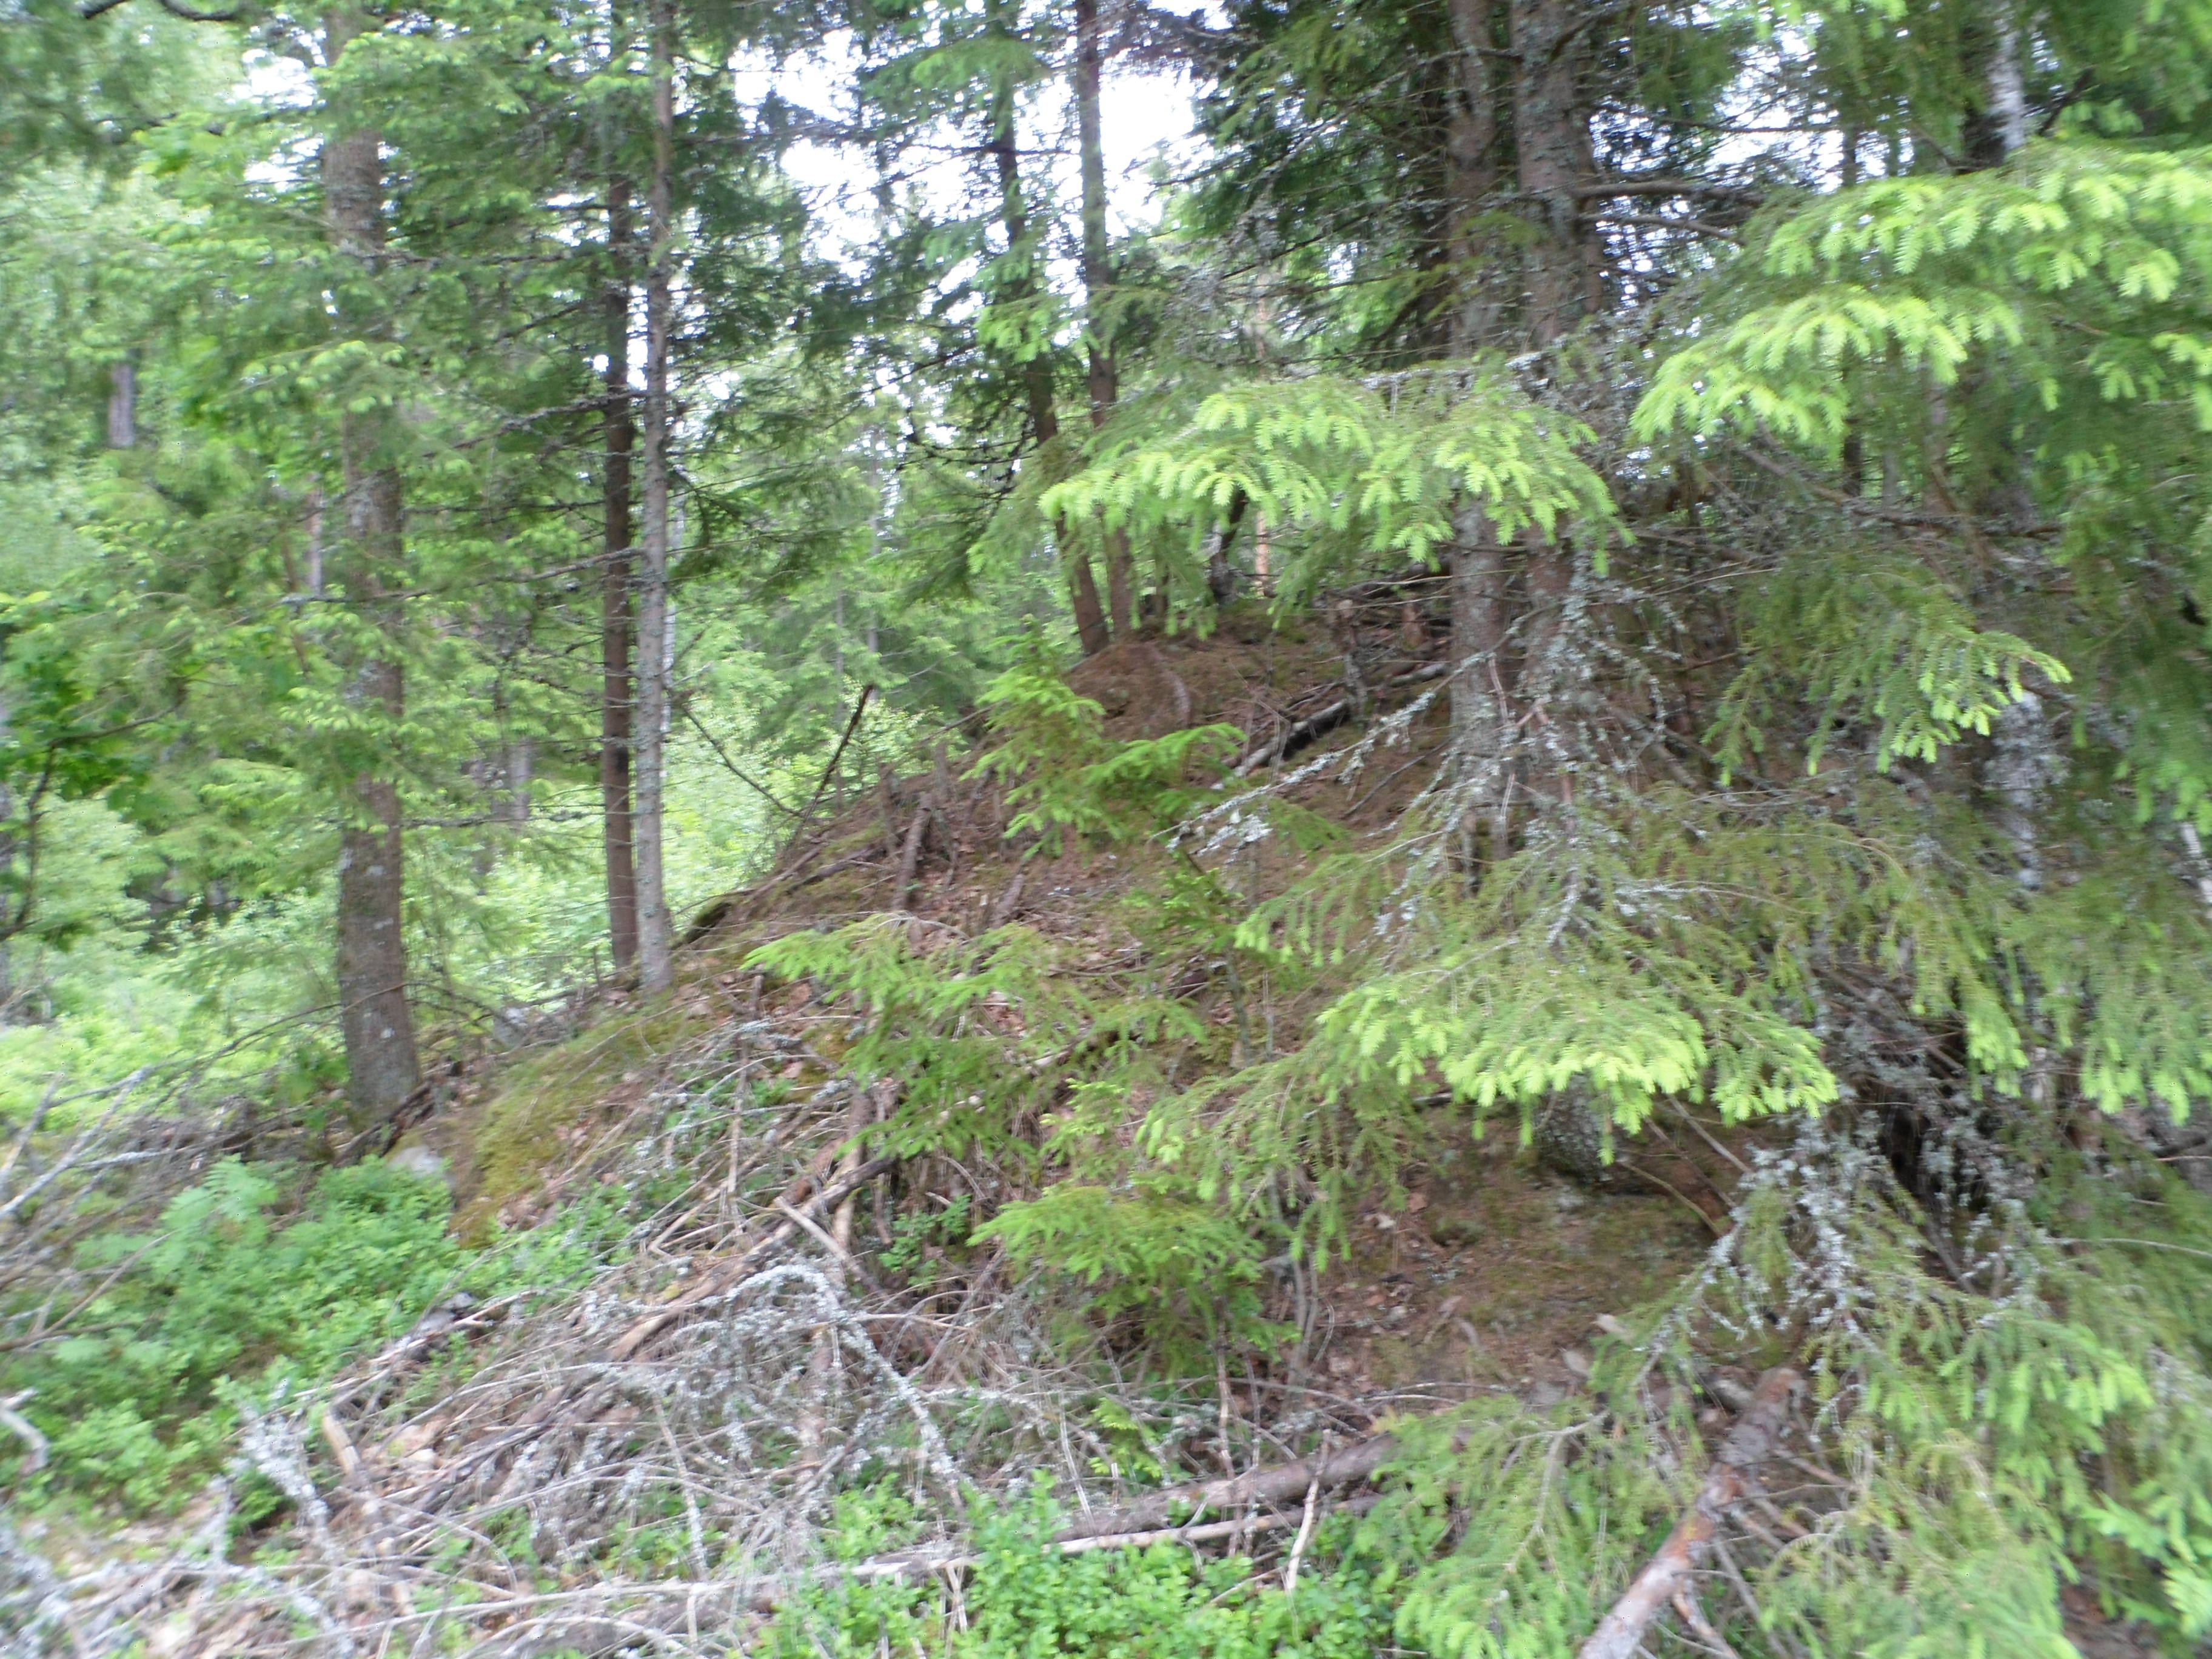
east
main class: Woodland
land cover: Spruce dominated mixed woodland
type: boreal forest
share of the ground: 25 - 50 %
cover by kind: lichens and mosses 25 %, broadleaved forest trees 20 %, unconsolidated bare surface 20 %, coniferous forest trees 15 %, shrubs 15 %, herbaceous plants 5 %
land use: Forestry
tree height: > 5 m
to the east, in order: Spruce dominated mixed woodland; Spruce dominated coniferous woodland; Fences; Grassland without tree/shrub cover; Fences; Grass margins; Paved roads, cycling and walking lanes; Grass margins; Fences; Grassland without tree/shrub cover; Electric lines; Grassland without tree/shrub cover; Broadleaved woodland
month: June
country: SE
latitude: 56.9906
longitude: 14.5227
